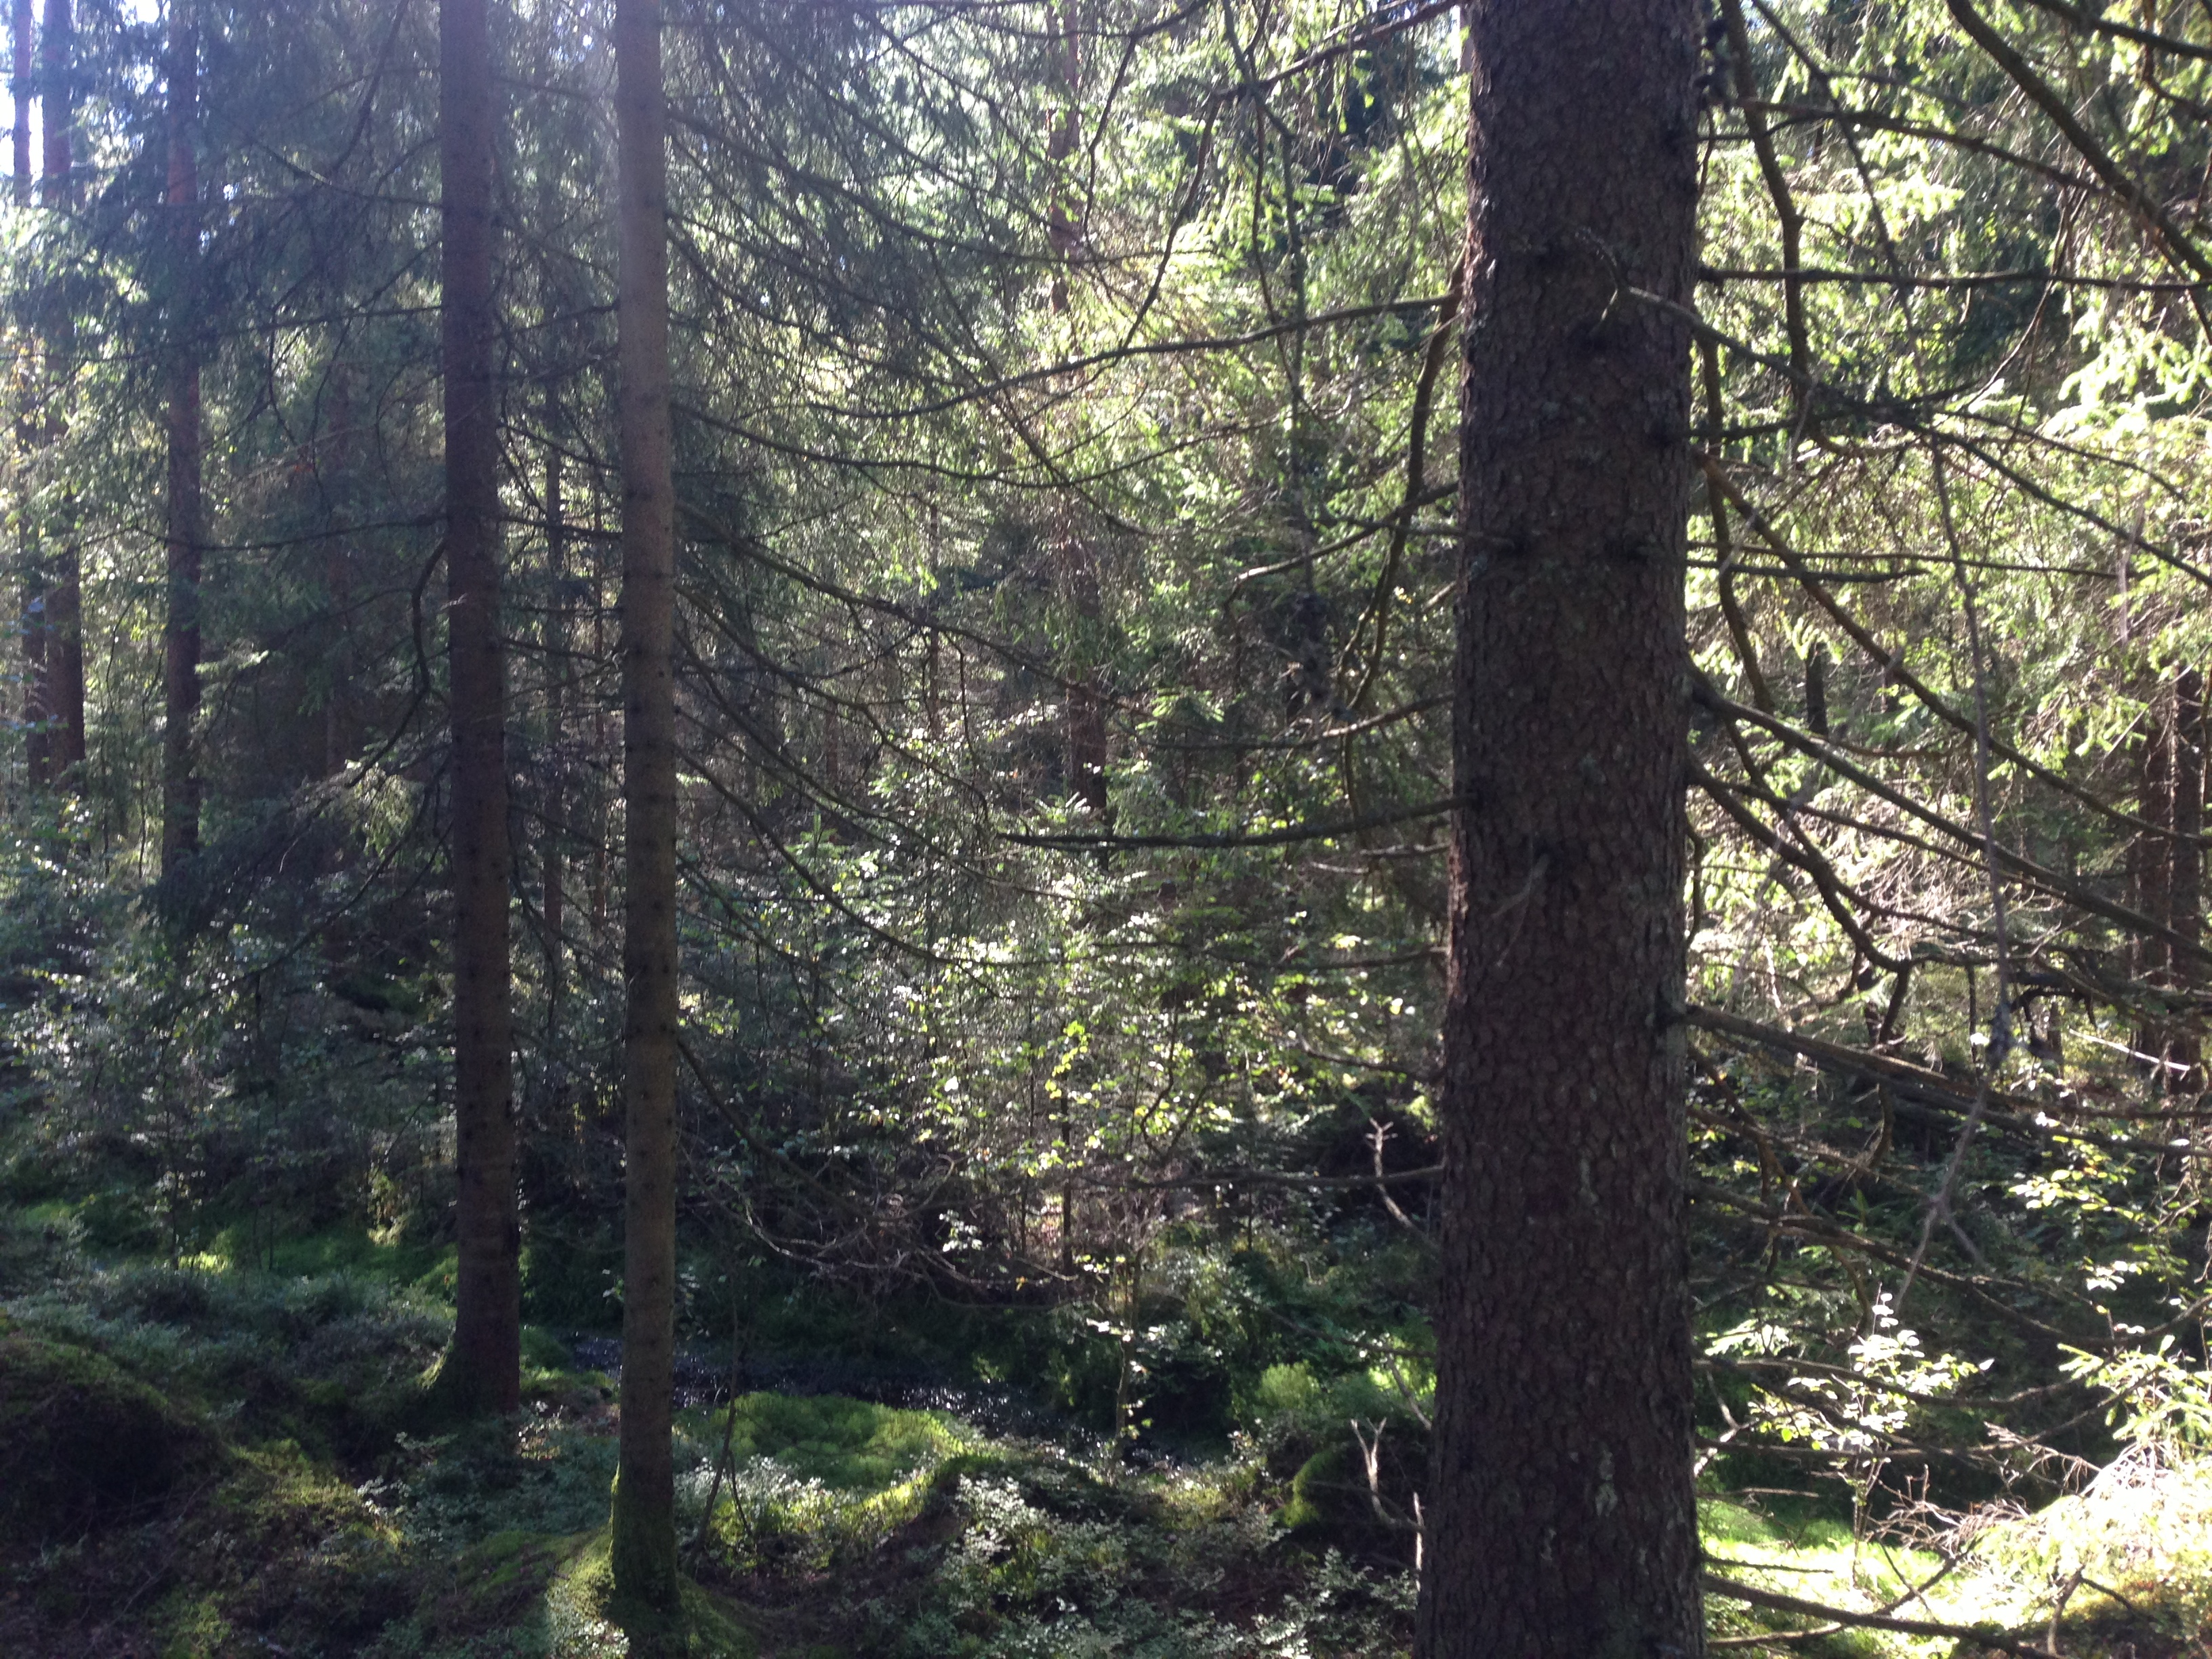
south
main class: Woodland
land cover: Spruce dominated coniferous woodland
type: boreal forest
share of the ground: > 75 %
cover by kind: coniferous forest trees 80 %, shrubs 20 %
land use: Forestry
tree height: > 5 m
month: September
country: SE
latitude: 57.1910
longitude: 13.2229
